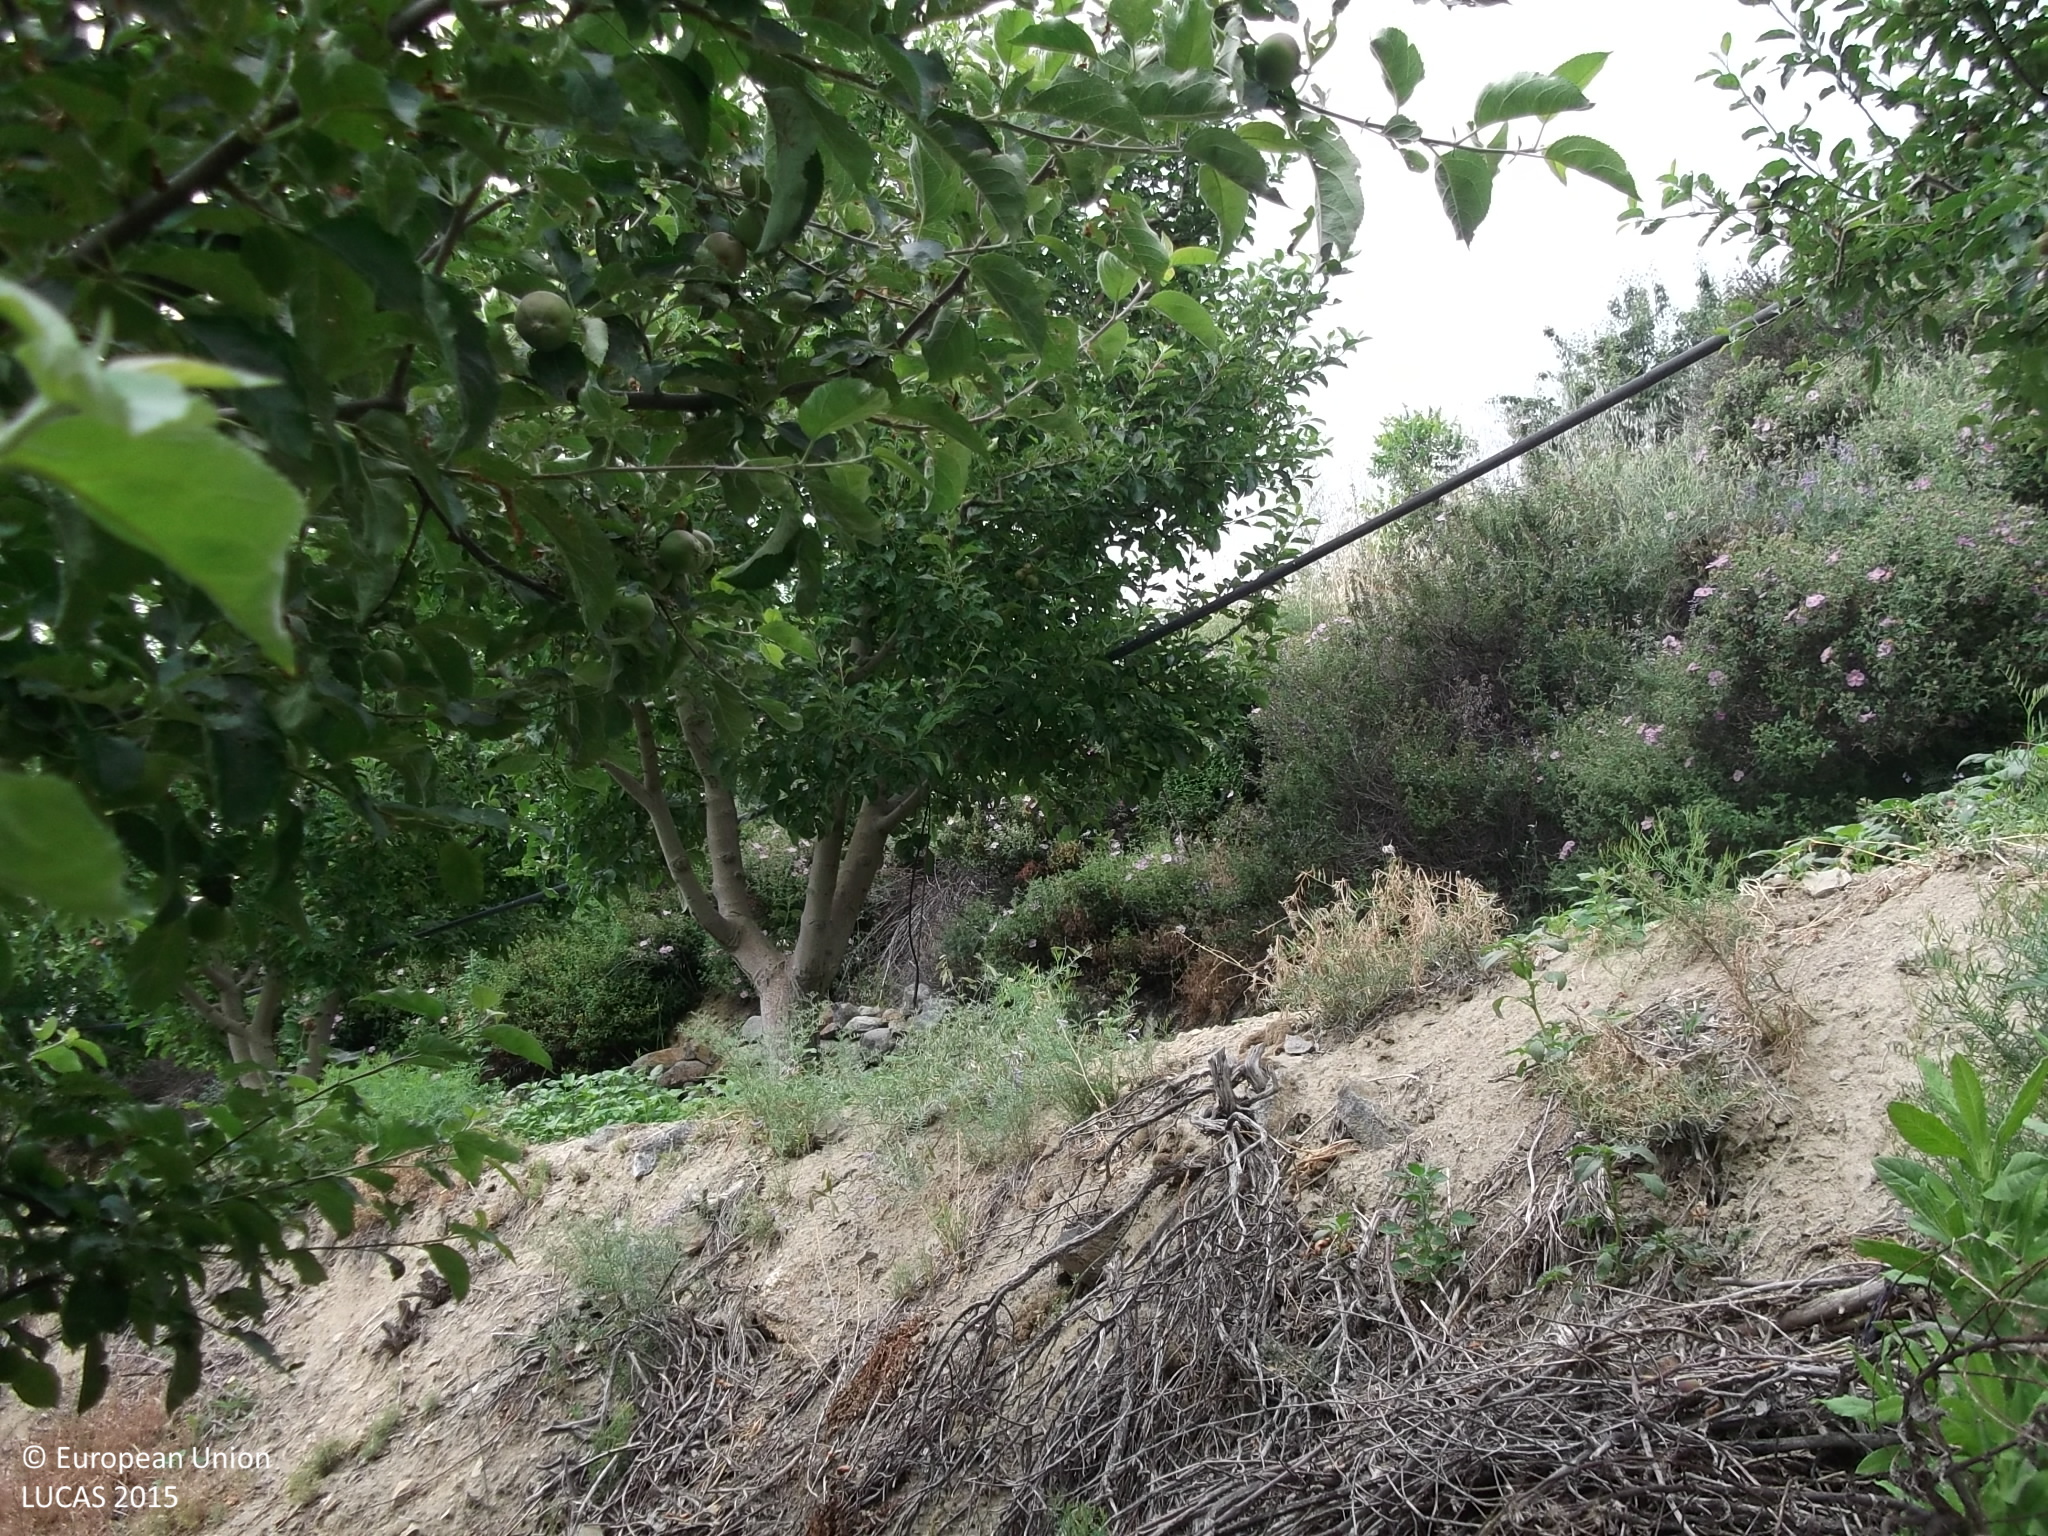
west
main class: Cropland
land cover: Apple fruit
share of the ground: > 75 %
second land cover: Grassland without tree/shrub cover
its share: 25 - 50 %
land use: Agriculture (excluding fallow land and kitchen gardens)
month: June
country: CY
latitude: 34.9371
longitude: 32.9535
